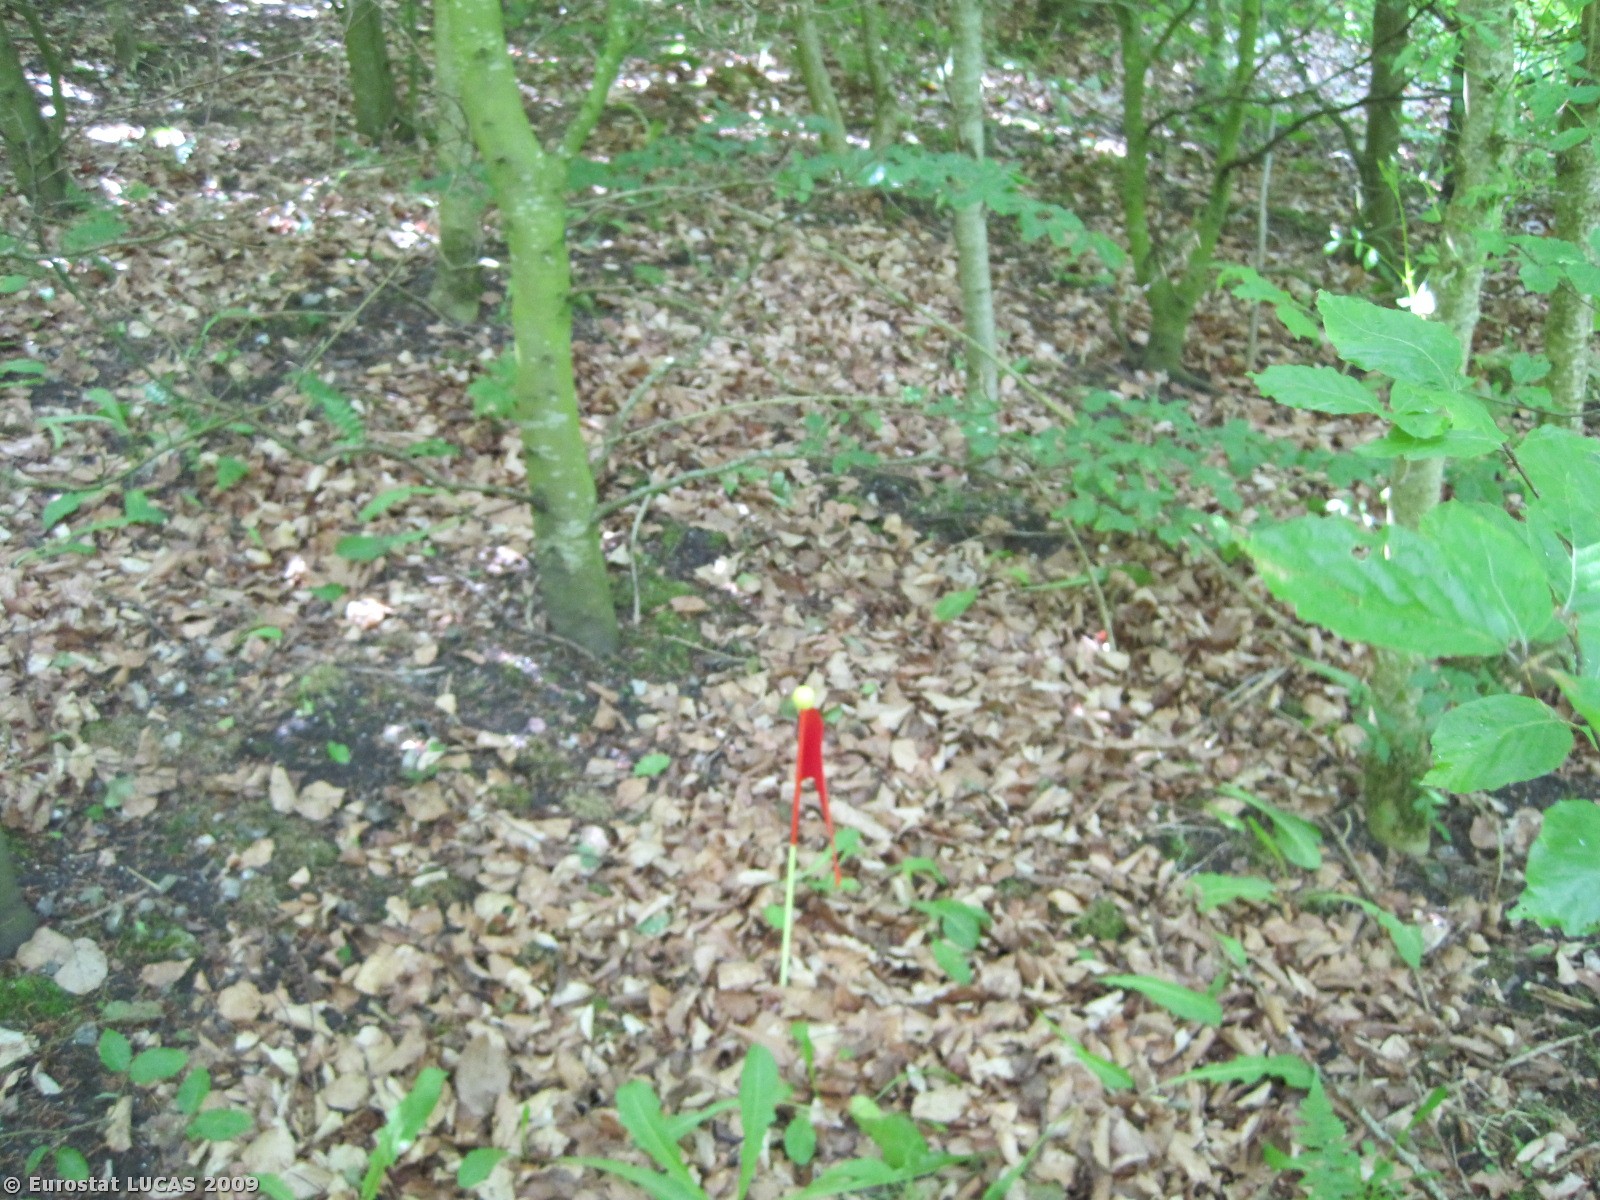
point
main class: Woodland
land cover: Broadleaved woodland
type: beech forest
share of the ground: > 75 %
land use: Forestry
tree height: > 5 m
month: May
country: DK
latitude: 56.5830
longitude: 9.7886
